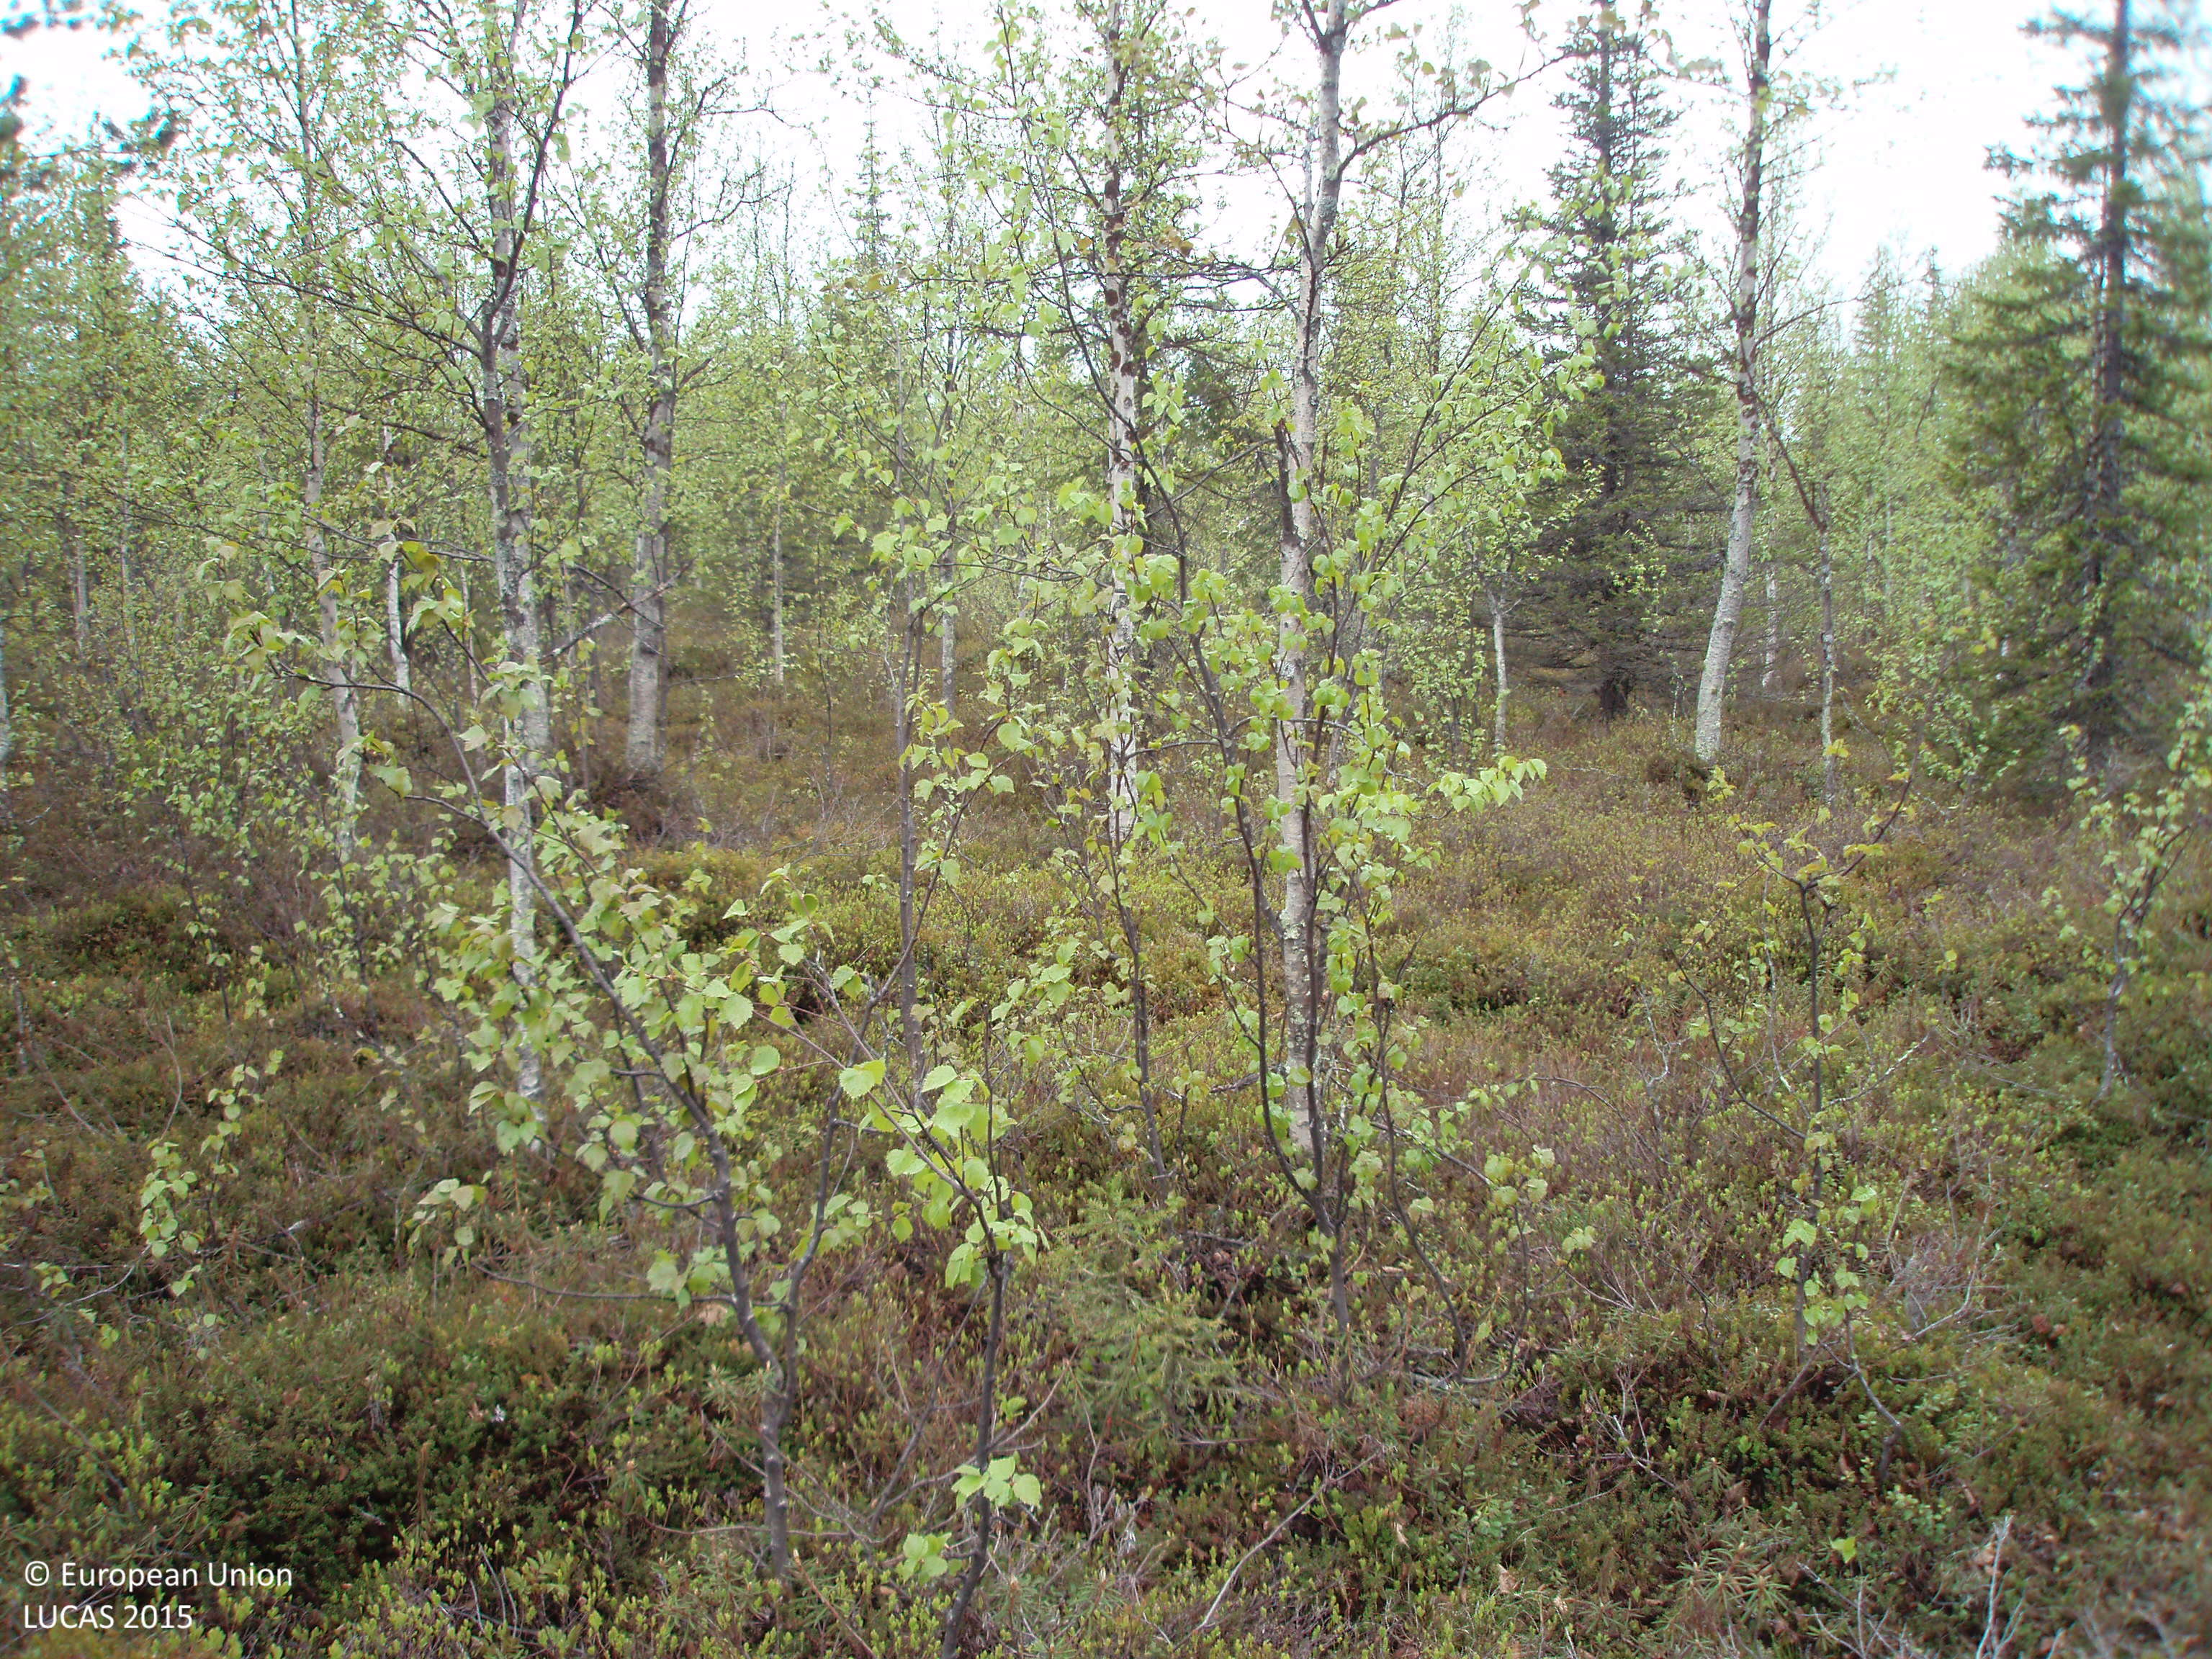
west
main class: Woodland
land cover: Other mixed woodland
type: boreal forest
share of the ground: 50 - 75 %
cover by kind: broadleaved forest trees 50 %, shrubs 30 %, coniferous forest trees 20 %
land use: Forestry
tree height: > 5 m
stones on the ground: 10 - 25 %
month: June
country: FI
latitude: 67.9230
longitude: 26.5887
